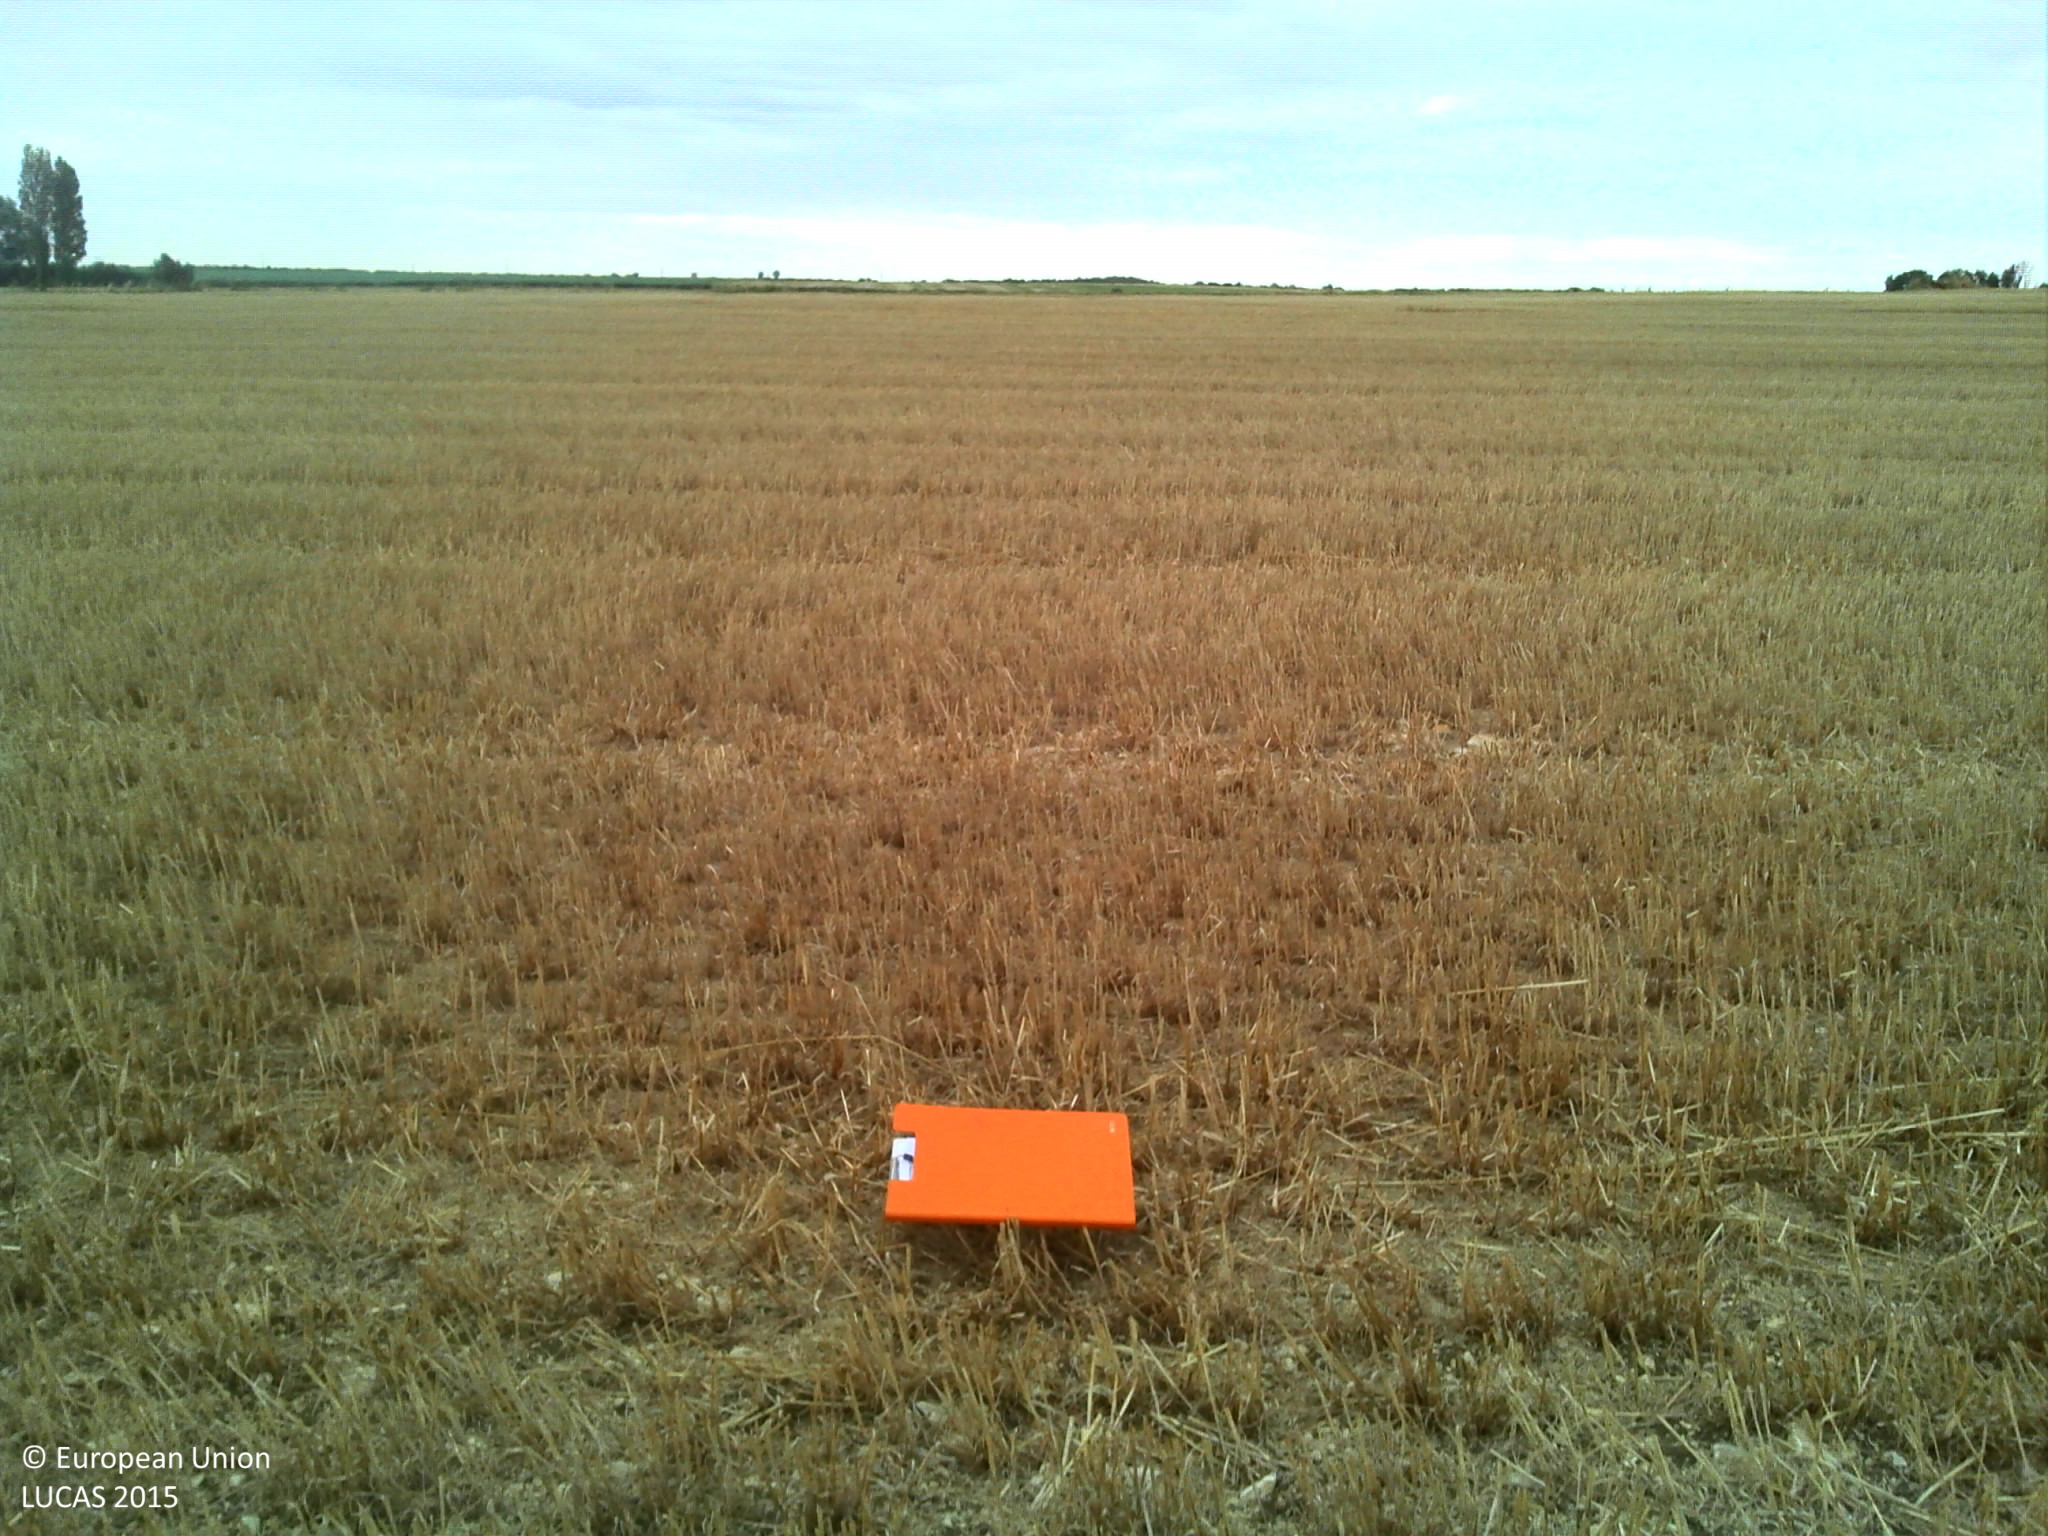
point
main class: Cropland
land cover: Common wheat
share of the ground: > 75 %
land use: Agriculture (excluding fallow land and kitchen gardens)
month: July
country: FR
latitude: 46.8310
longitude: 2.2711
